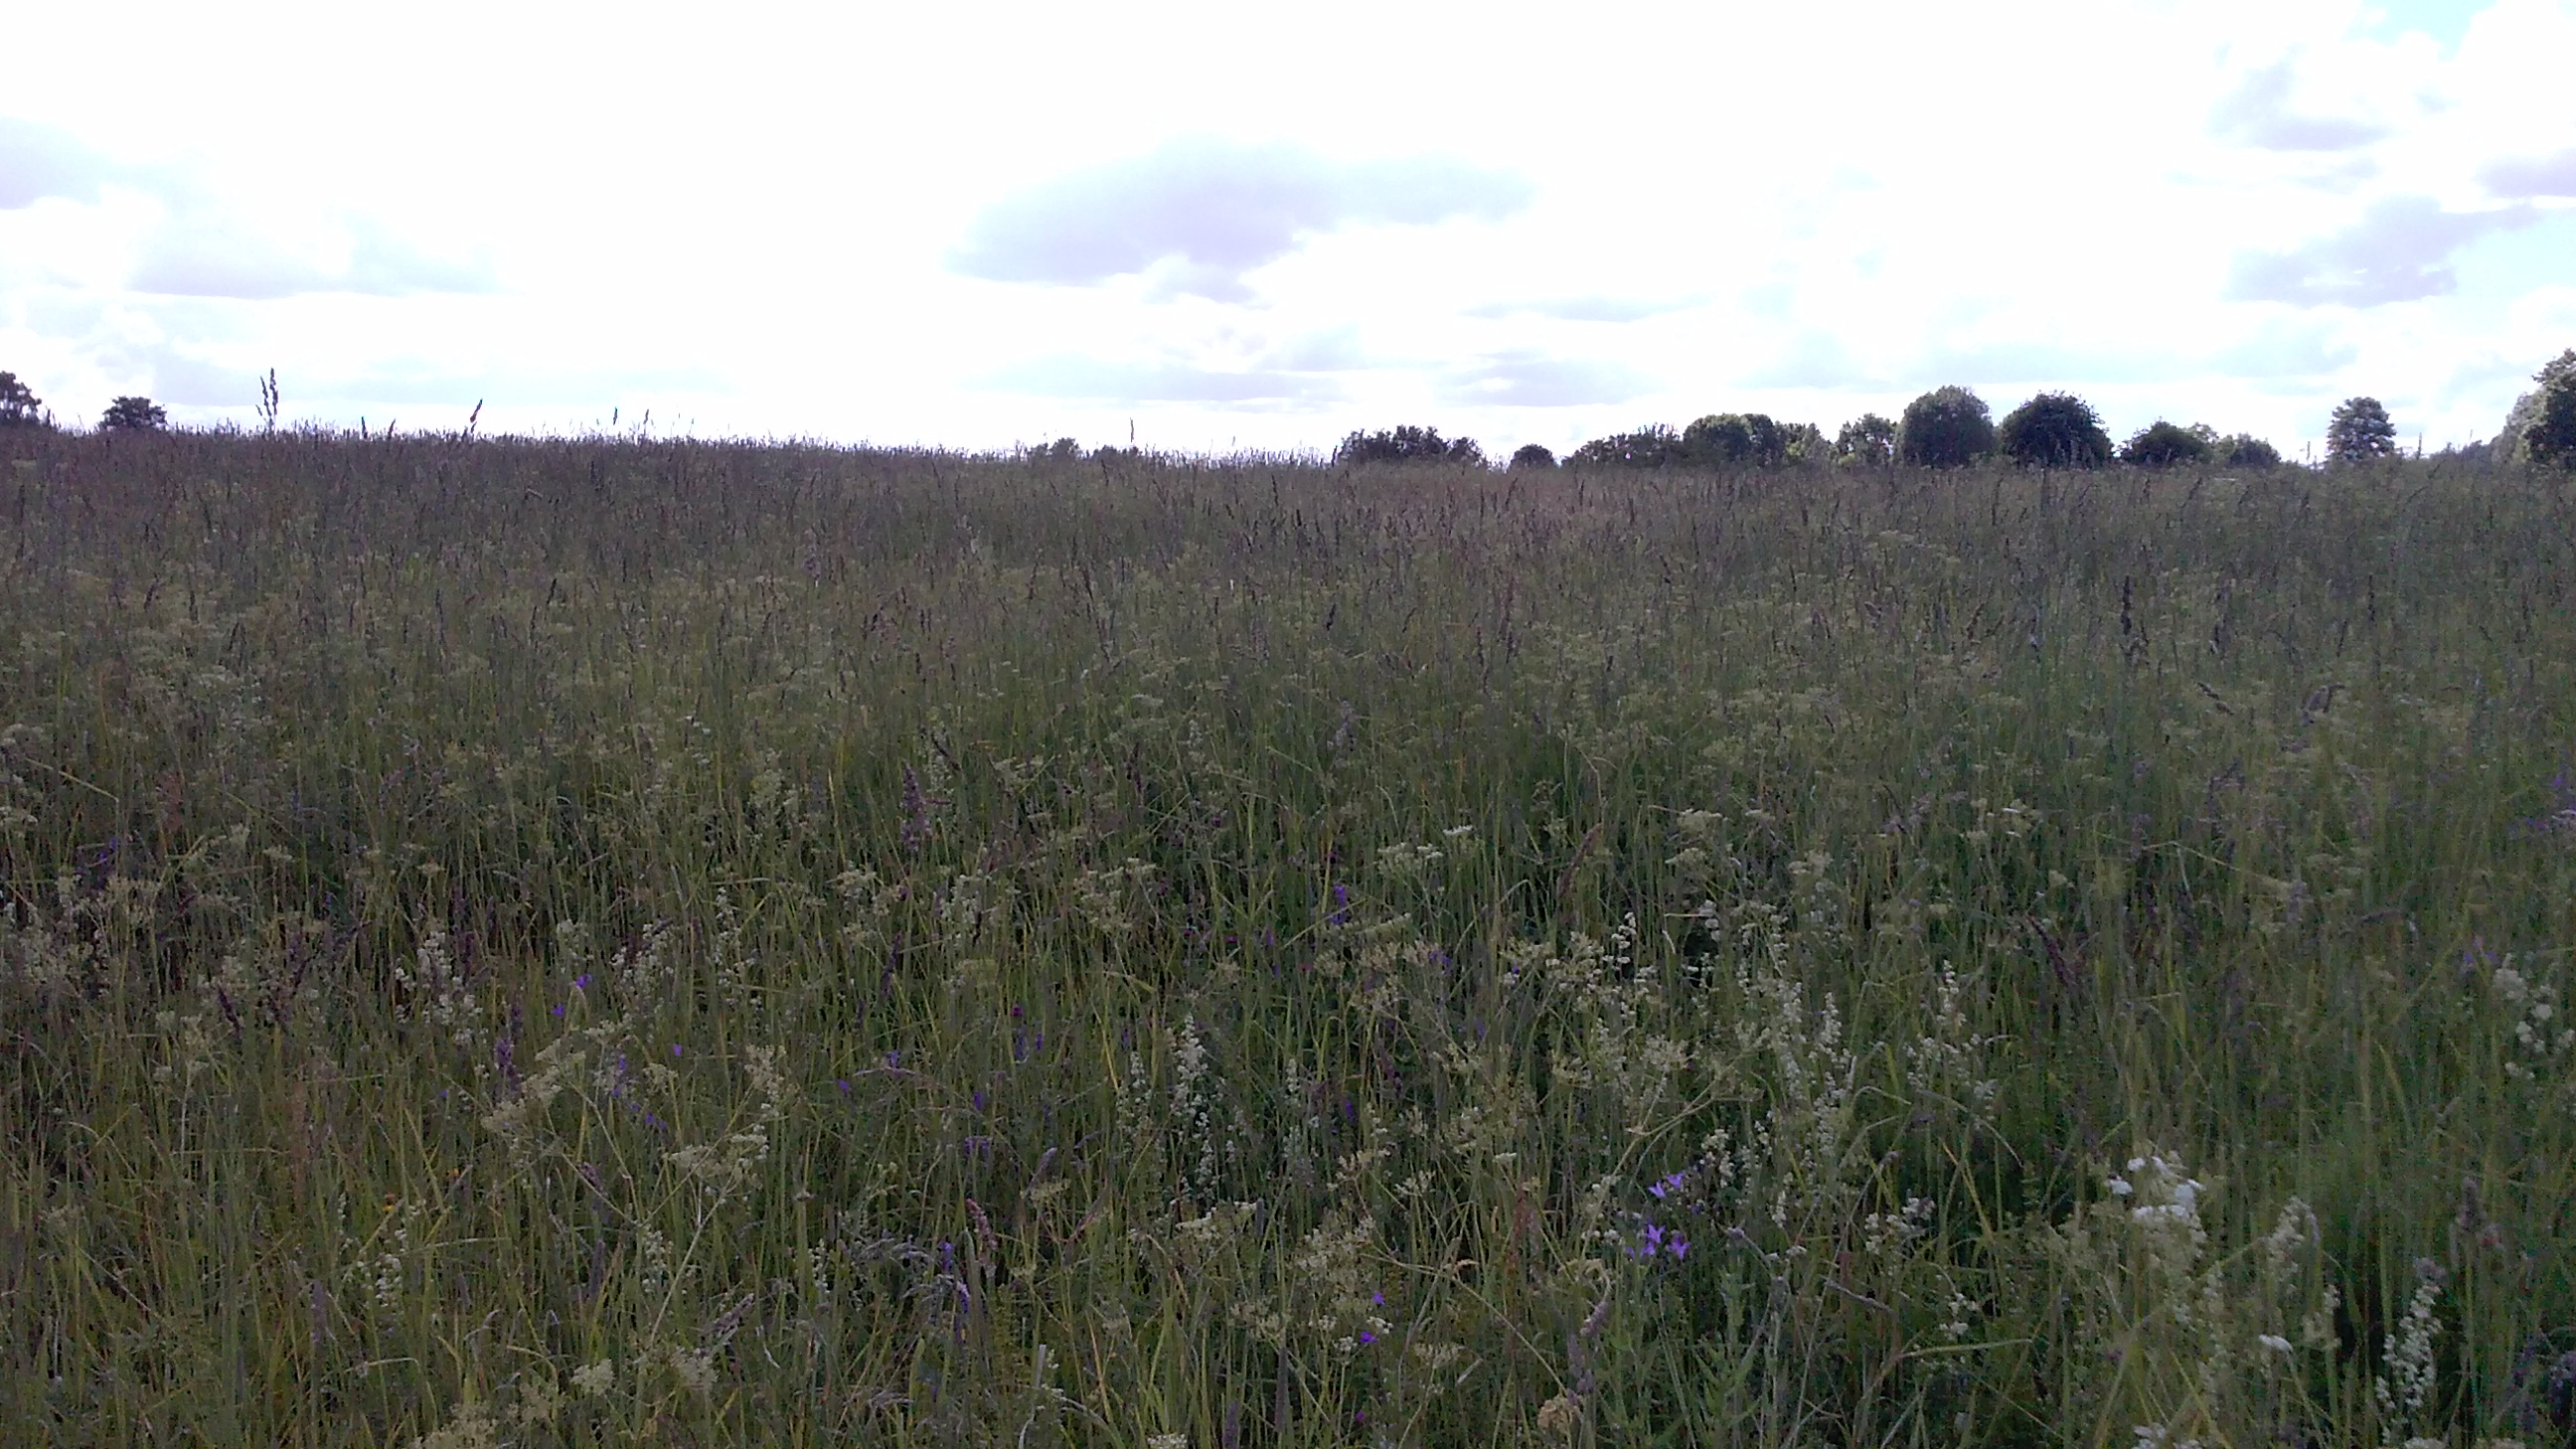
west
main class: Grassland
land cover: Grassland without tree/shrub cover
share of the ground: > 75 %
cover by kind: herbaceous plants 100 %
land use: Agriculture (excluding fallow land and kitchen gardens)
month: June
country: LV
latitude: 56.5389
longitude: 27.9022
